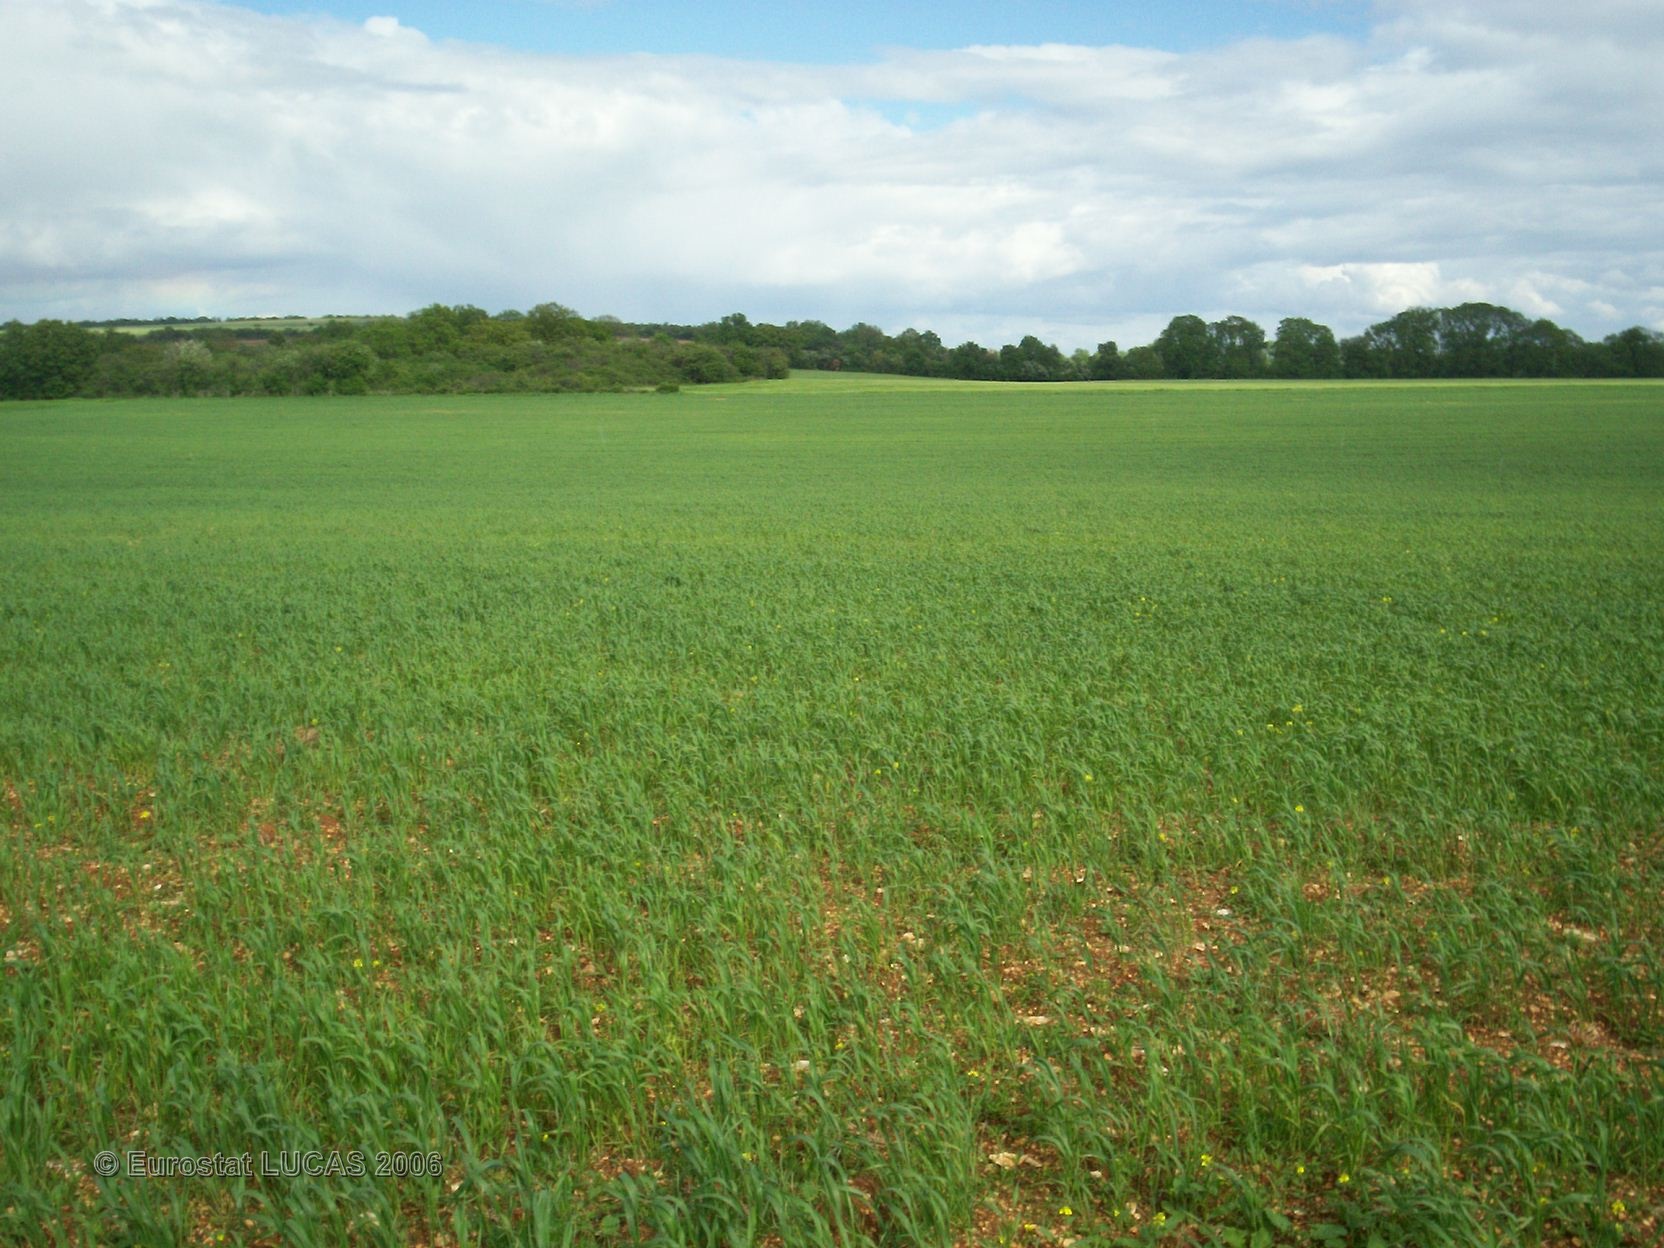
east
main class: Cropland
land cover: Barley
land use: Agriculture (excluding fallow land and kitchen gardens)
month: May
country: FR
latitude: 47.0125
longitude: 4.6730
